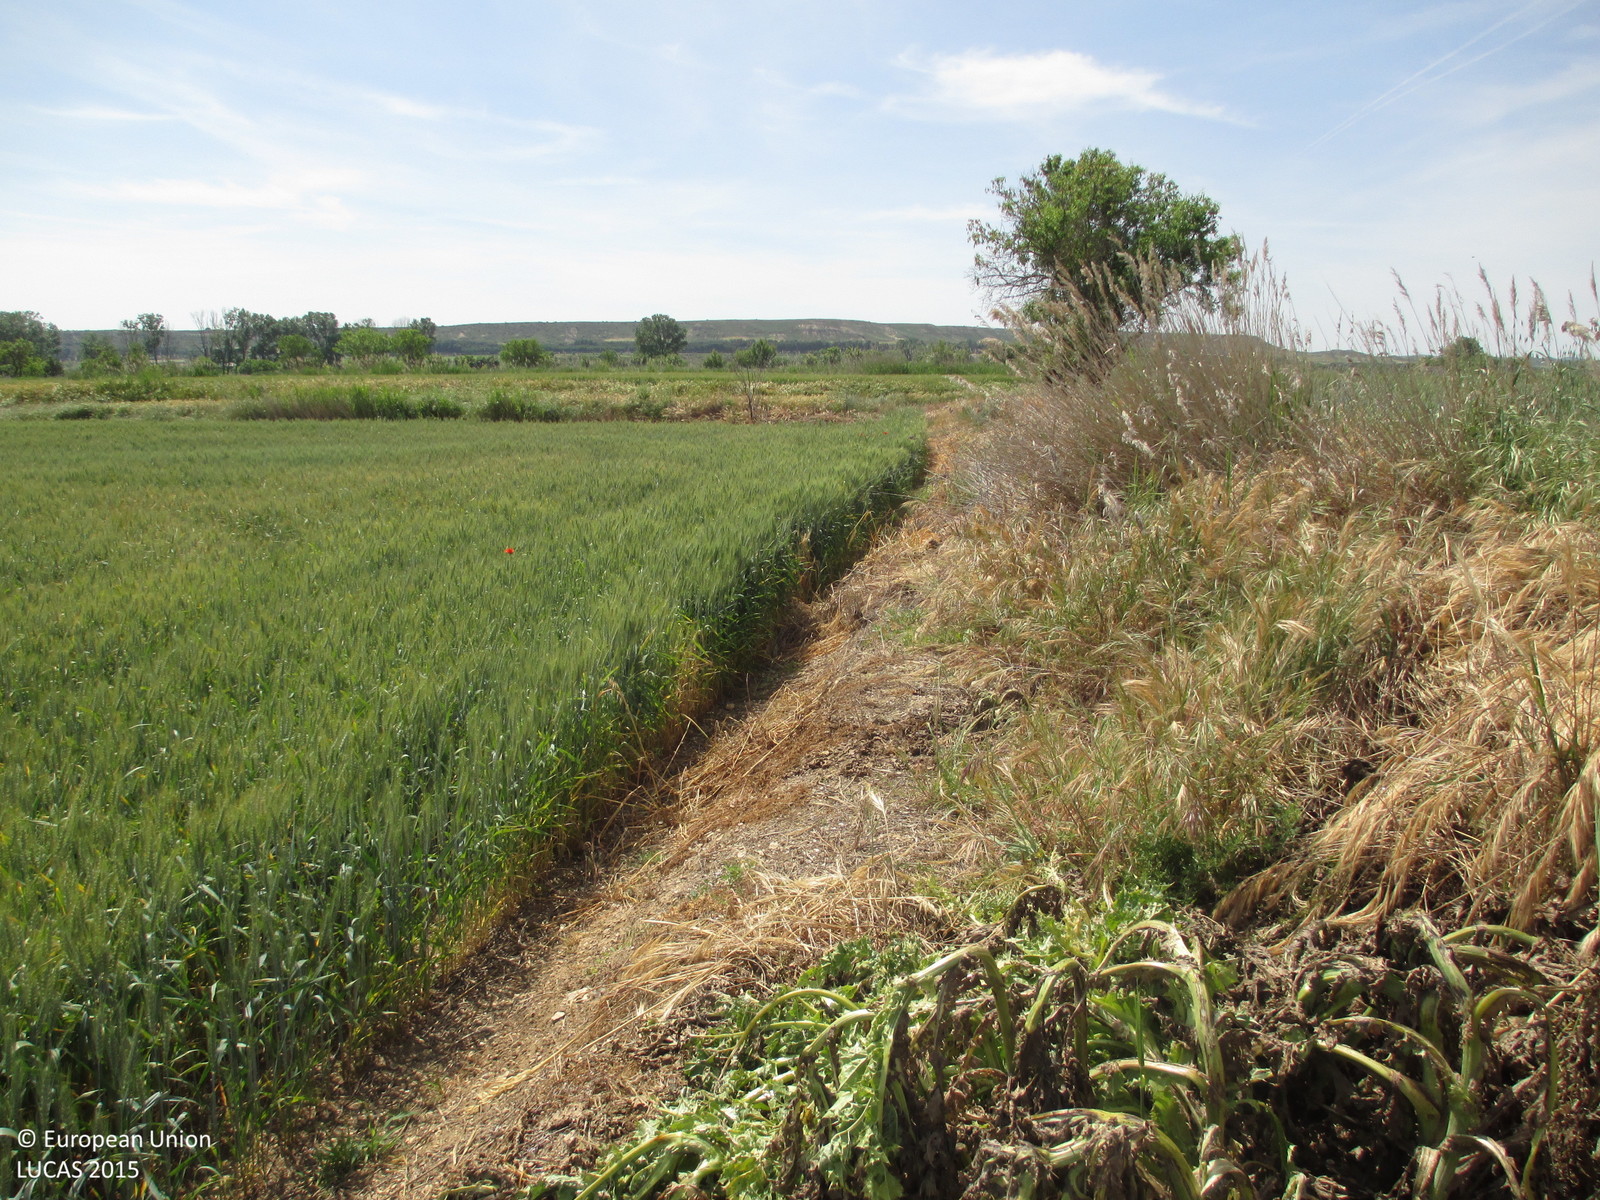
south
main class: Grassland
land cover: Spontaneously vegetated surfaces
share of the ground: > 75 %
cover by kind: herbaceous plants 100 %
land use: Agriculture (excluding fallow land and kitchen gardens)
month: May
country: ES
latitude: 41.8786
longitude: -0.4195
